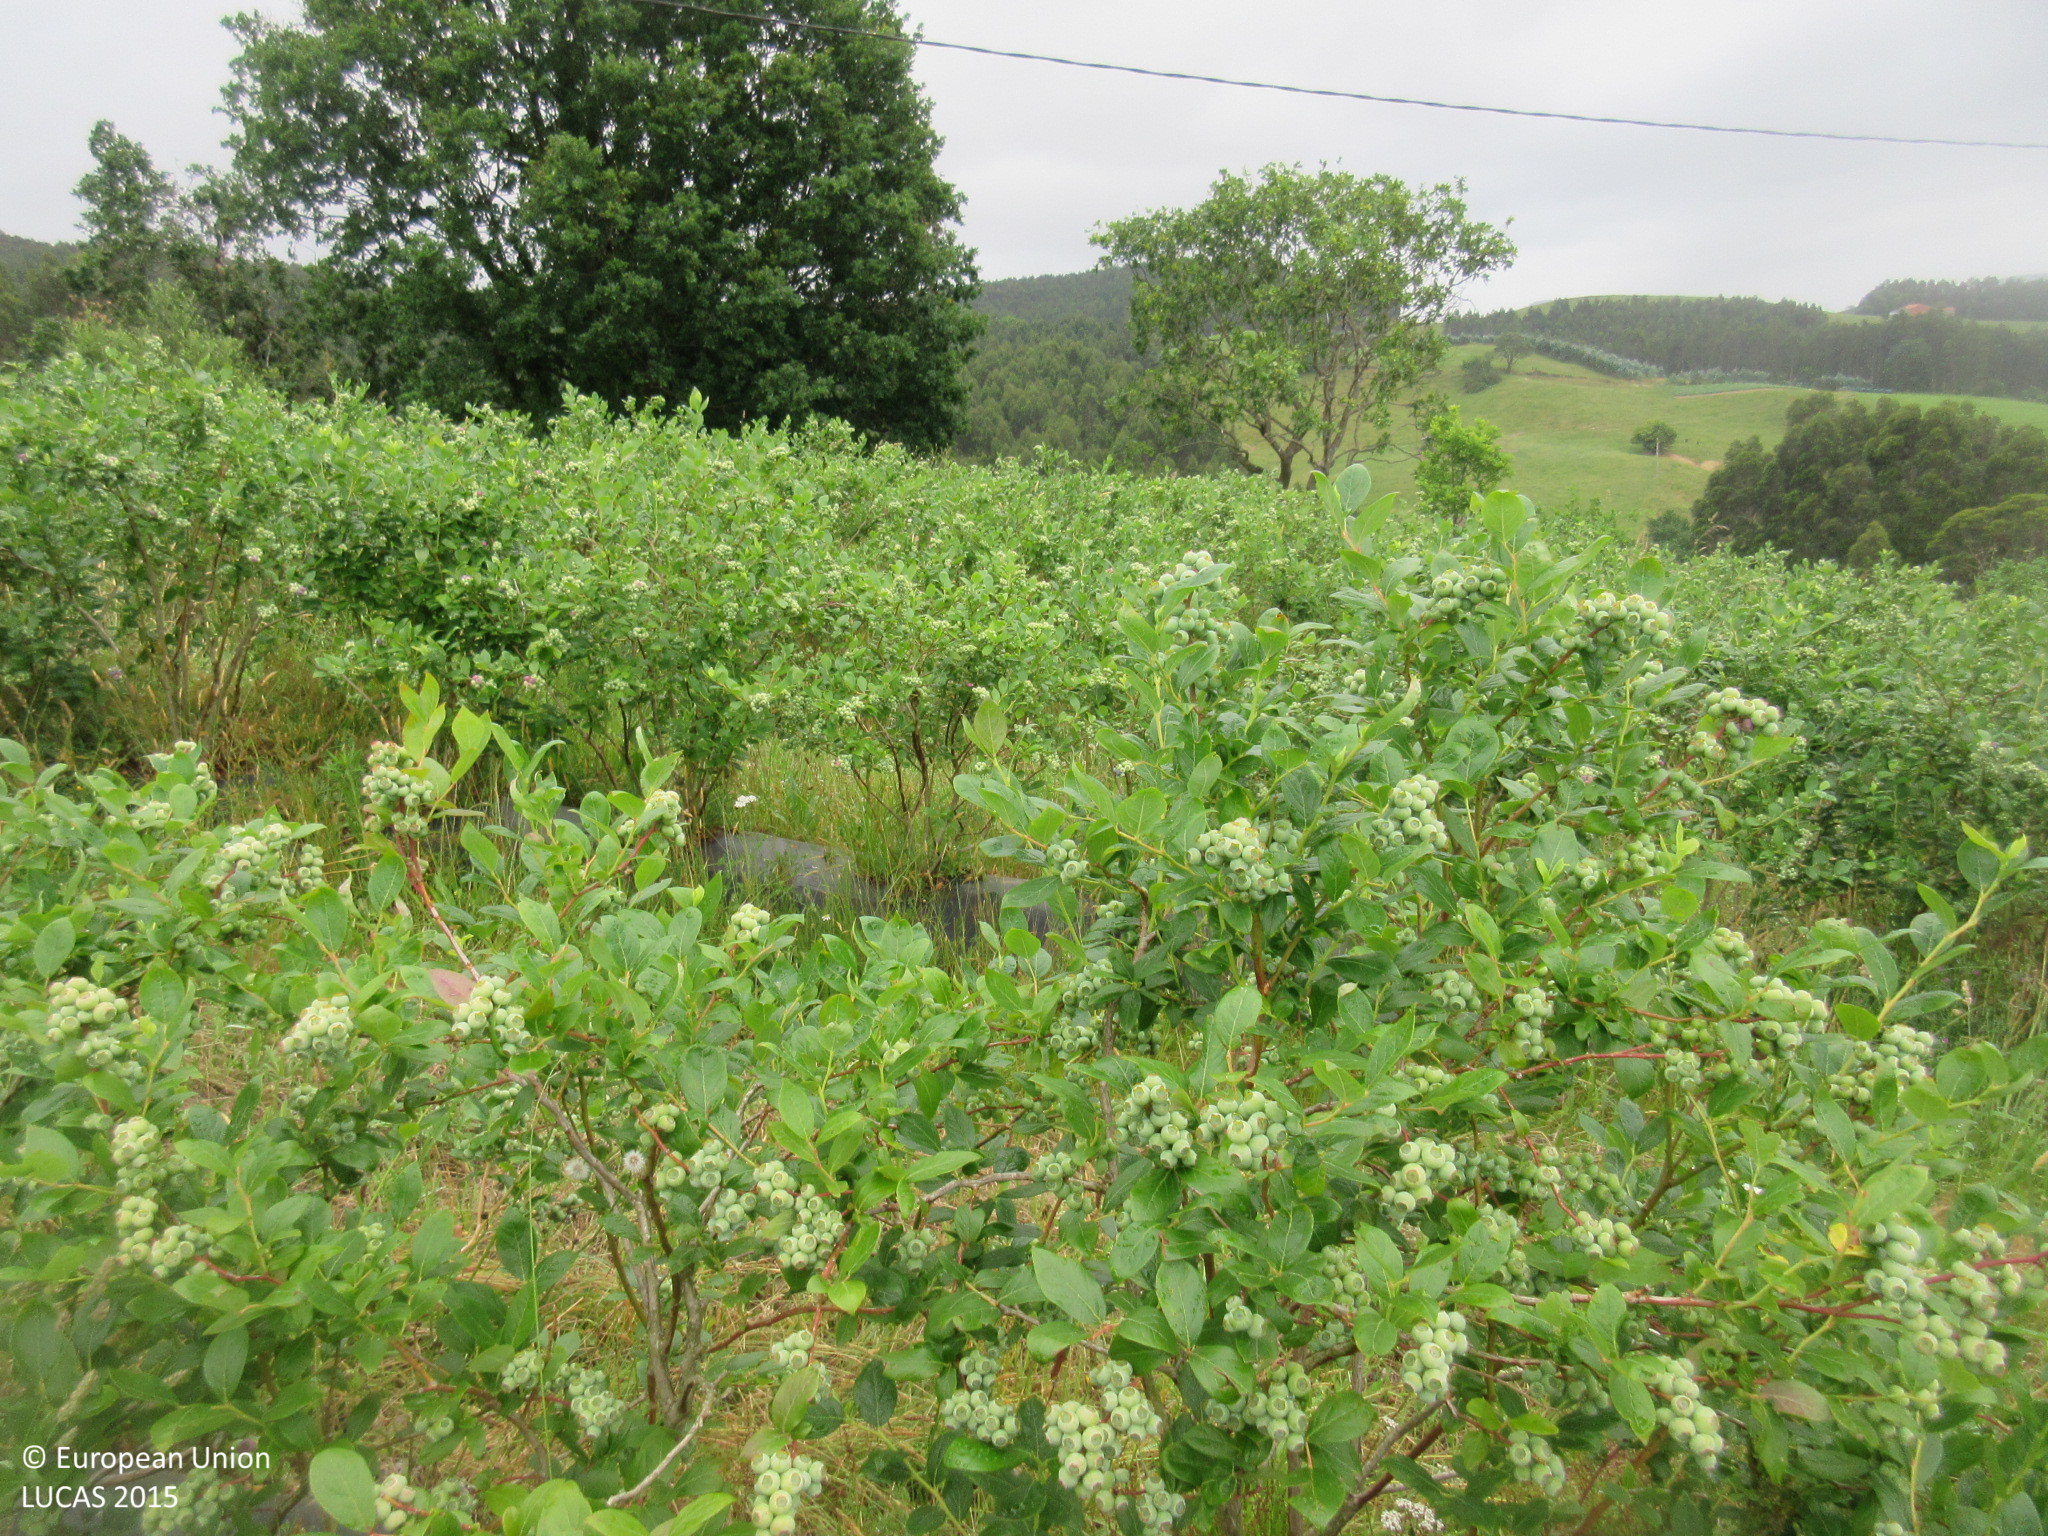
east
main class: Cropland
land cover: Other fruit trees and berries
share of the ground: 25 - 50 %
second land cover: Spontaneously vegetated surfaces
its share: > 75 %
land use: Agriculture (excluding fallow land and kitchen gardens)
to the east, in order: Other fruit trees and berries; Spontaneously vegetated surfaces; Electric lines; Other fruit trees and berries; Fences; Grassland with sparse tree/shrub cover; Fences; Tracks; Grassland without tree/shrub cover; Fences; Grassland without tree/shrub cover; Single bushes/trees; Grassland without tree/shrub cover; Grassland with sparse tree/shrub cover; Broadleaved woodland; Grassland with sparse tree/shrub cover; Artificial constructions in urban areas; Grassland with sparse tree/shrub cover; Tracks; Grassland without tree/shrub cover
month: June
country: ES
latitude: 43.4646
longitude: -3.6303
